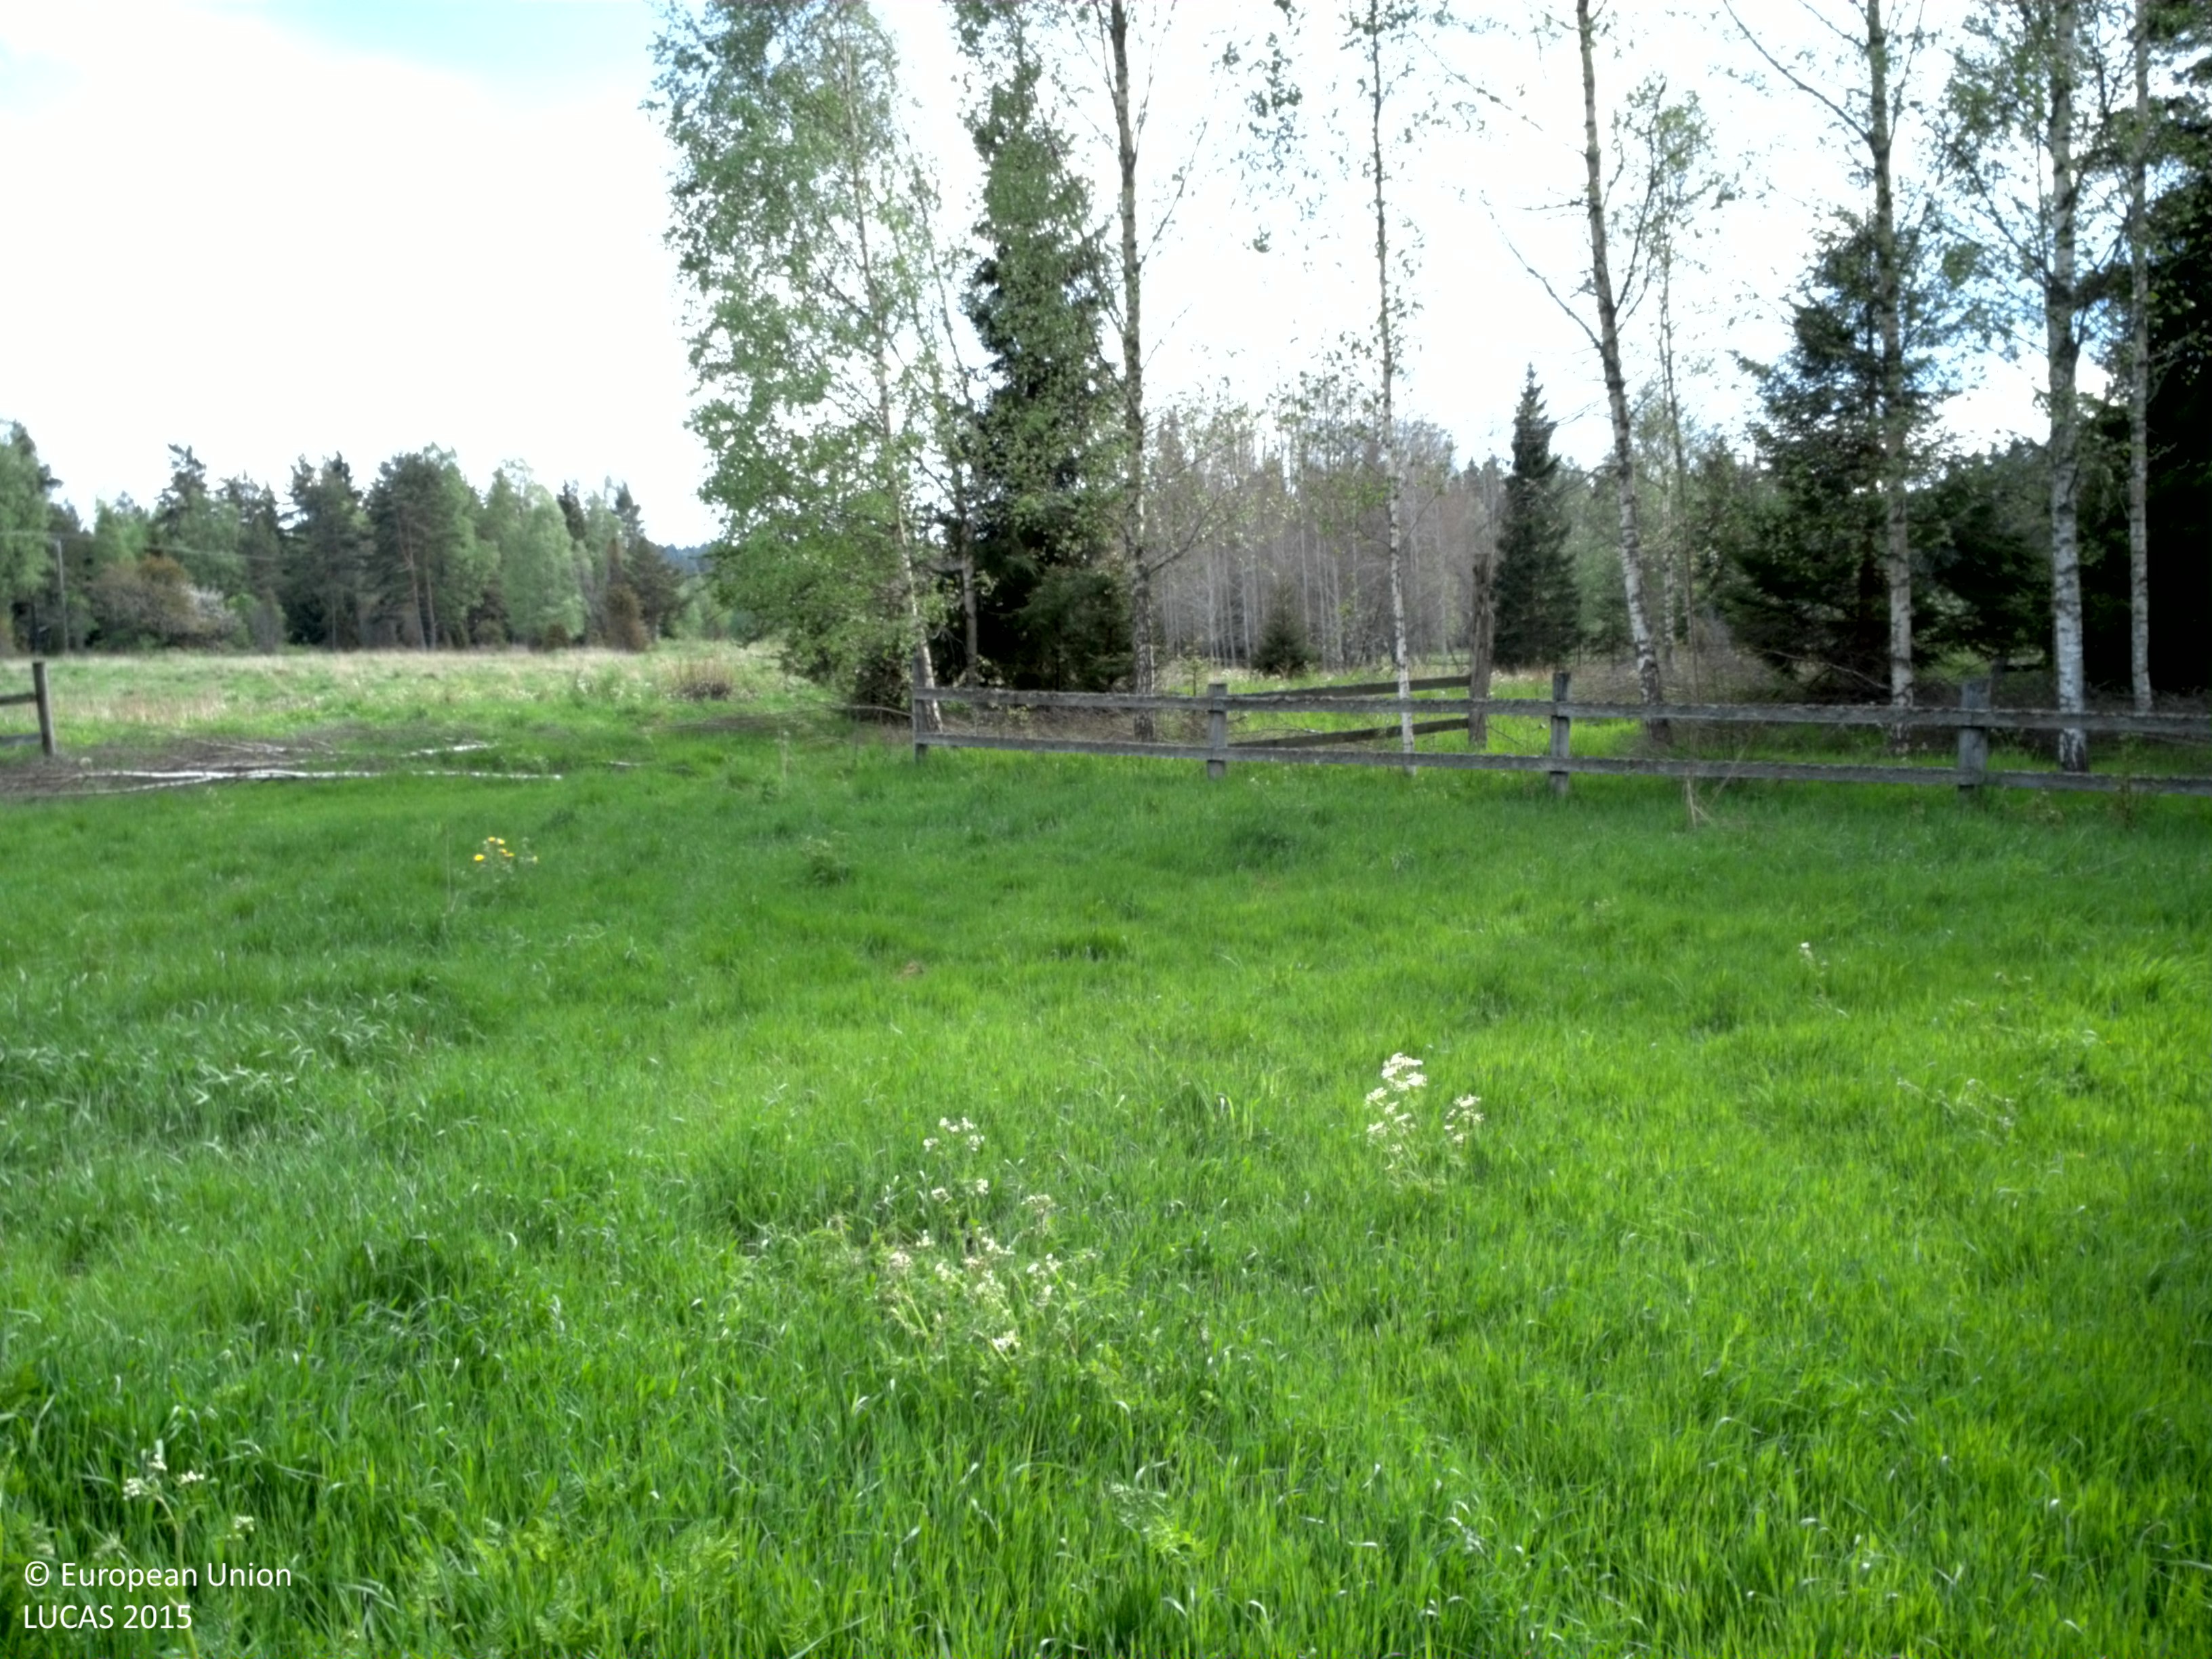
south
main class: Grassland
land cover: Grassland with sparse tree/shrub cover
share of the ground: > 75 %
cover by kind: herbaceous plants 95 %, coniferous forest trees 5 %
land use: Agriculture (excluding fallow land and kitchen gardens)
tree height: > 5 m
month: May
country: SE
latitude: 57.4049
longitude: 15.4728
